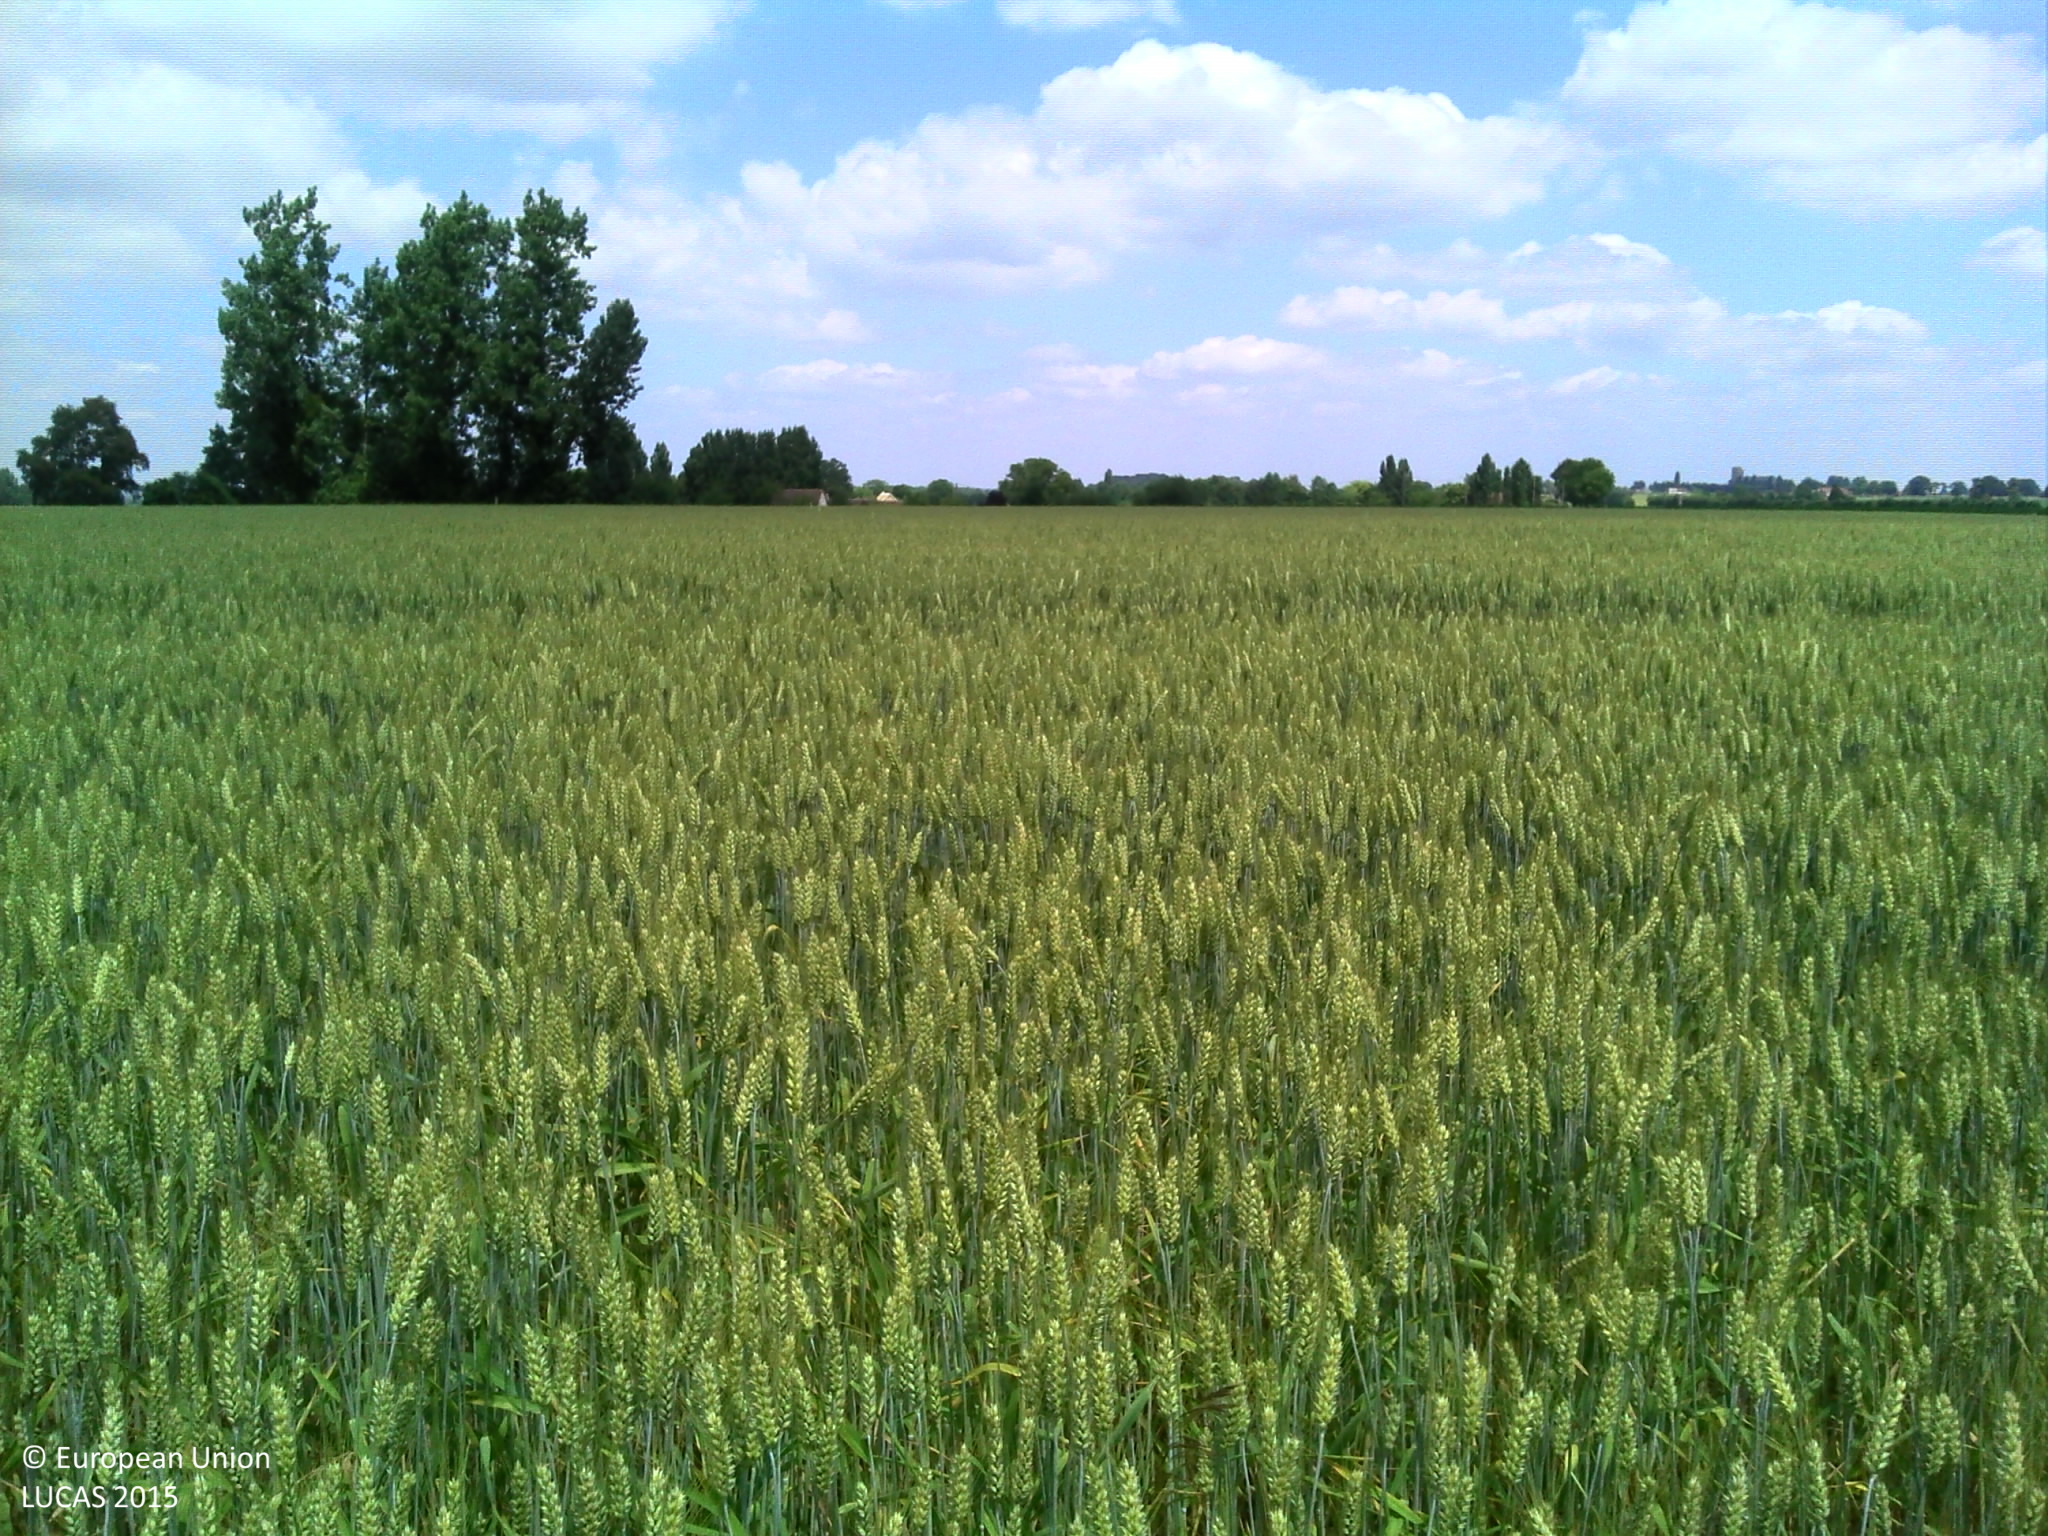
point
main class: Cropland
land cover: Common wheat
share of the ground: > 75 %
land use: Agriculture (excluding fallow land and kitchen gardens)
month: June
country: FR
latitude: 48.2246
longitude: 0.2413
